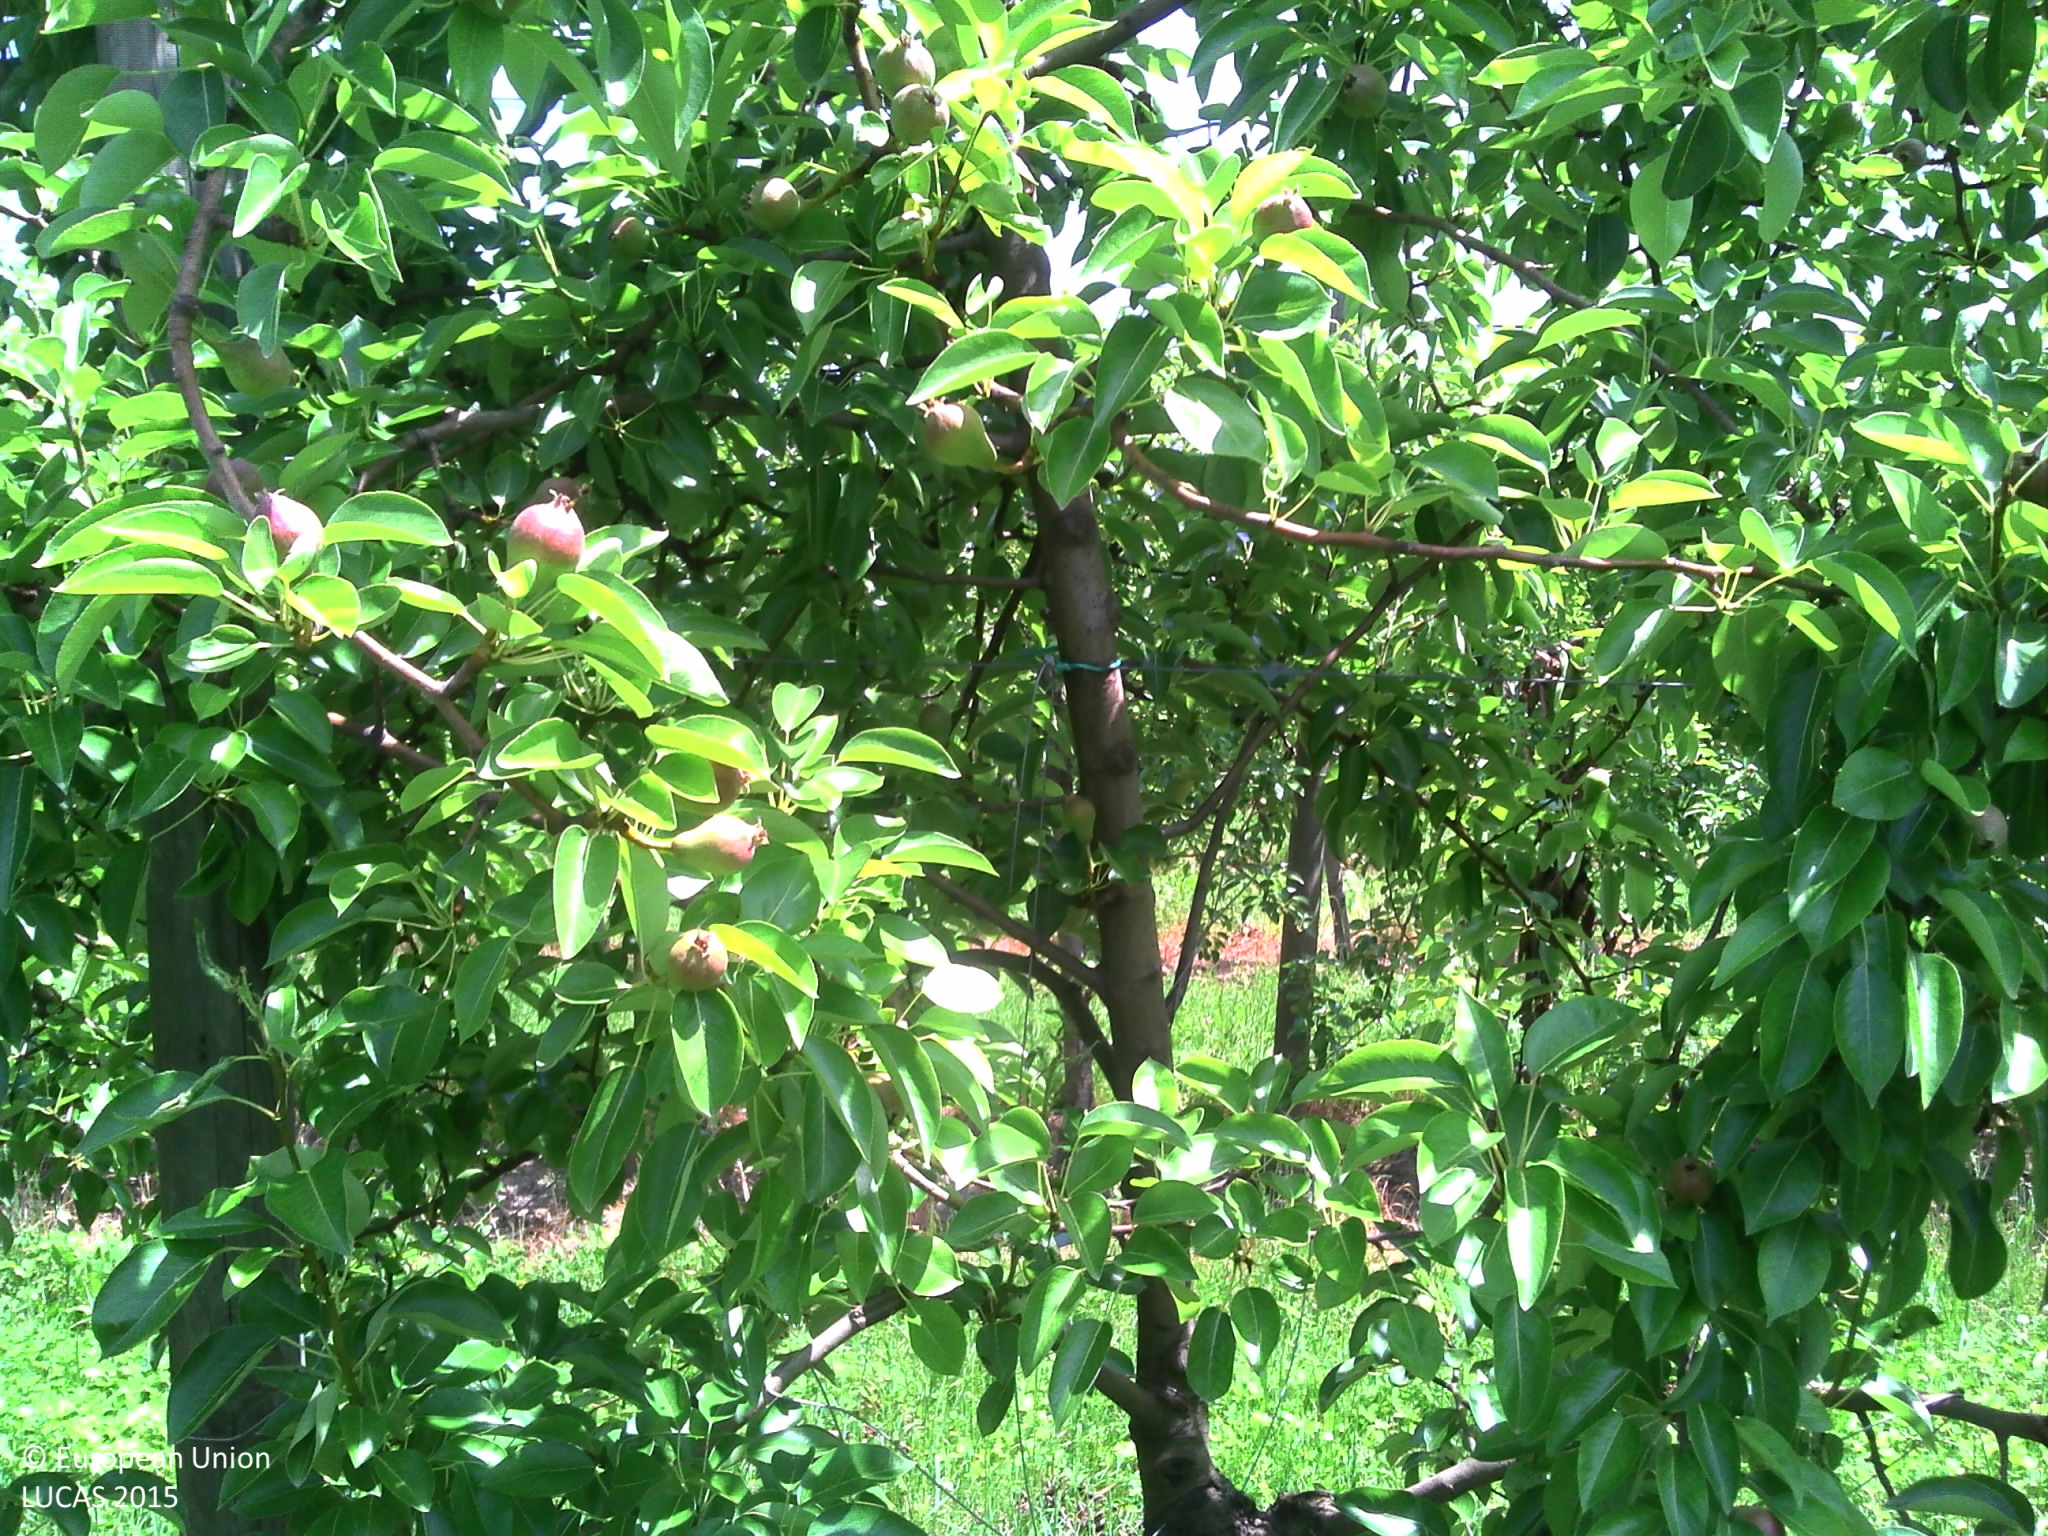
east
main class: Cropland
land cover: Pear fruit
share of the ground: 50 - 75 %
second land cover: Grassland without tree/shrub cover
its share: 50 - 75 %
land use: Agriculture (excluding fallow land and kitchen gardens)
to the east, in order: Pear fruit; Grassland without tree/shrub cover; Paved roads, cycling and walking lanes; Electric lines; Ditches and canals; Common wheat
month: June
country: FR
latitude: 46.4802
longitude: 4.8569
